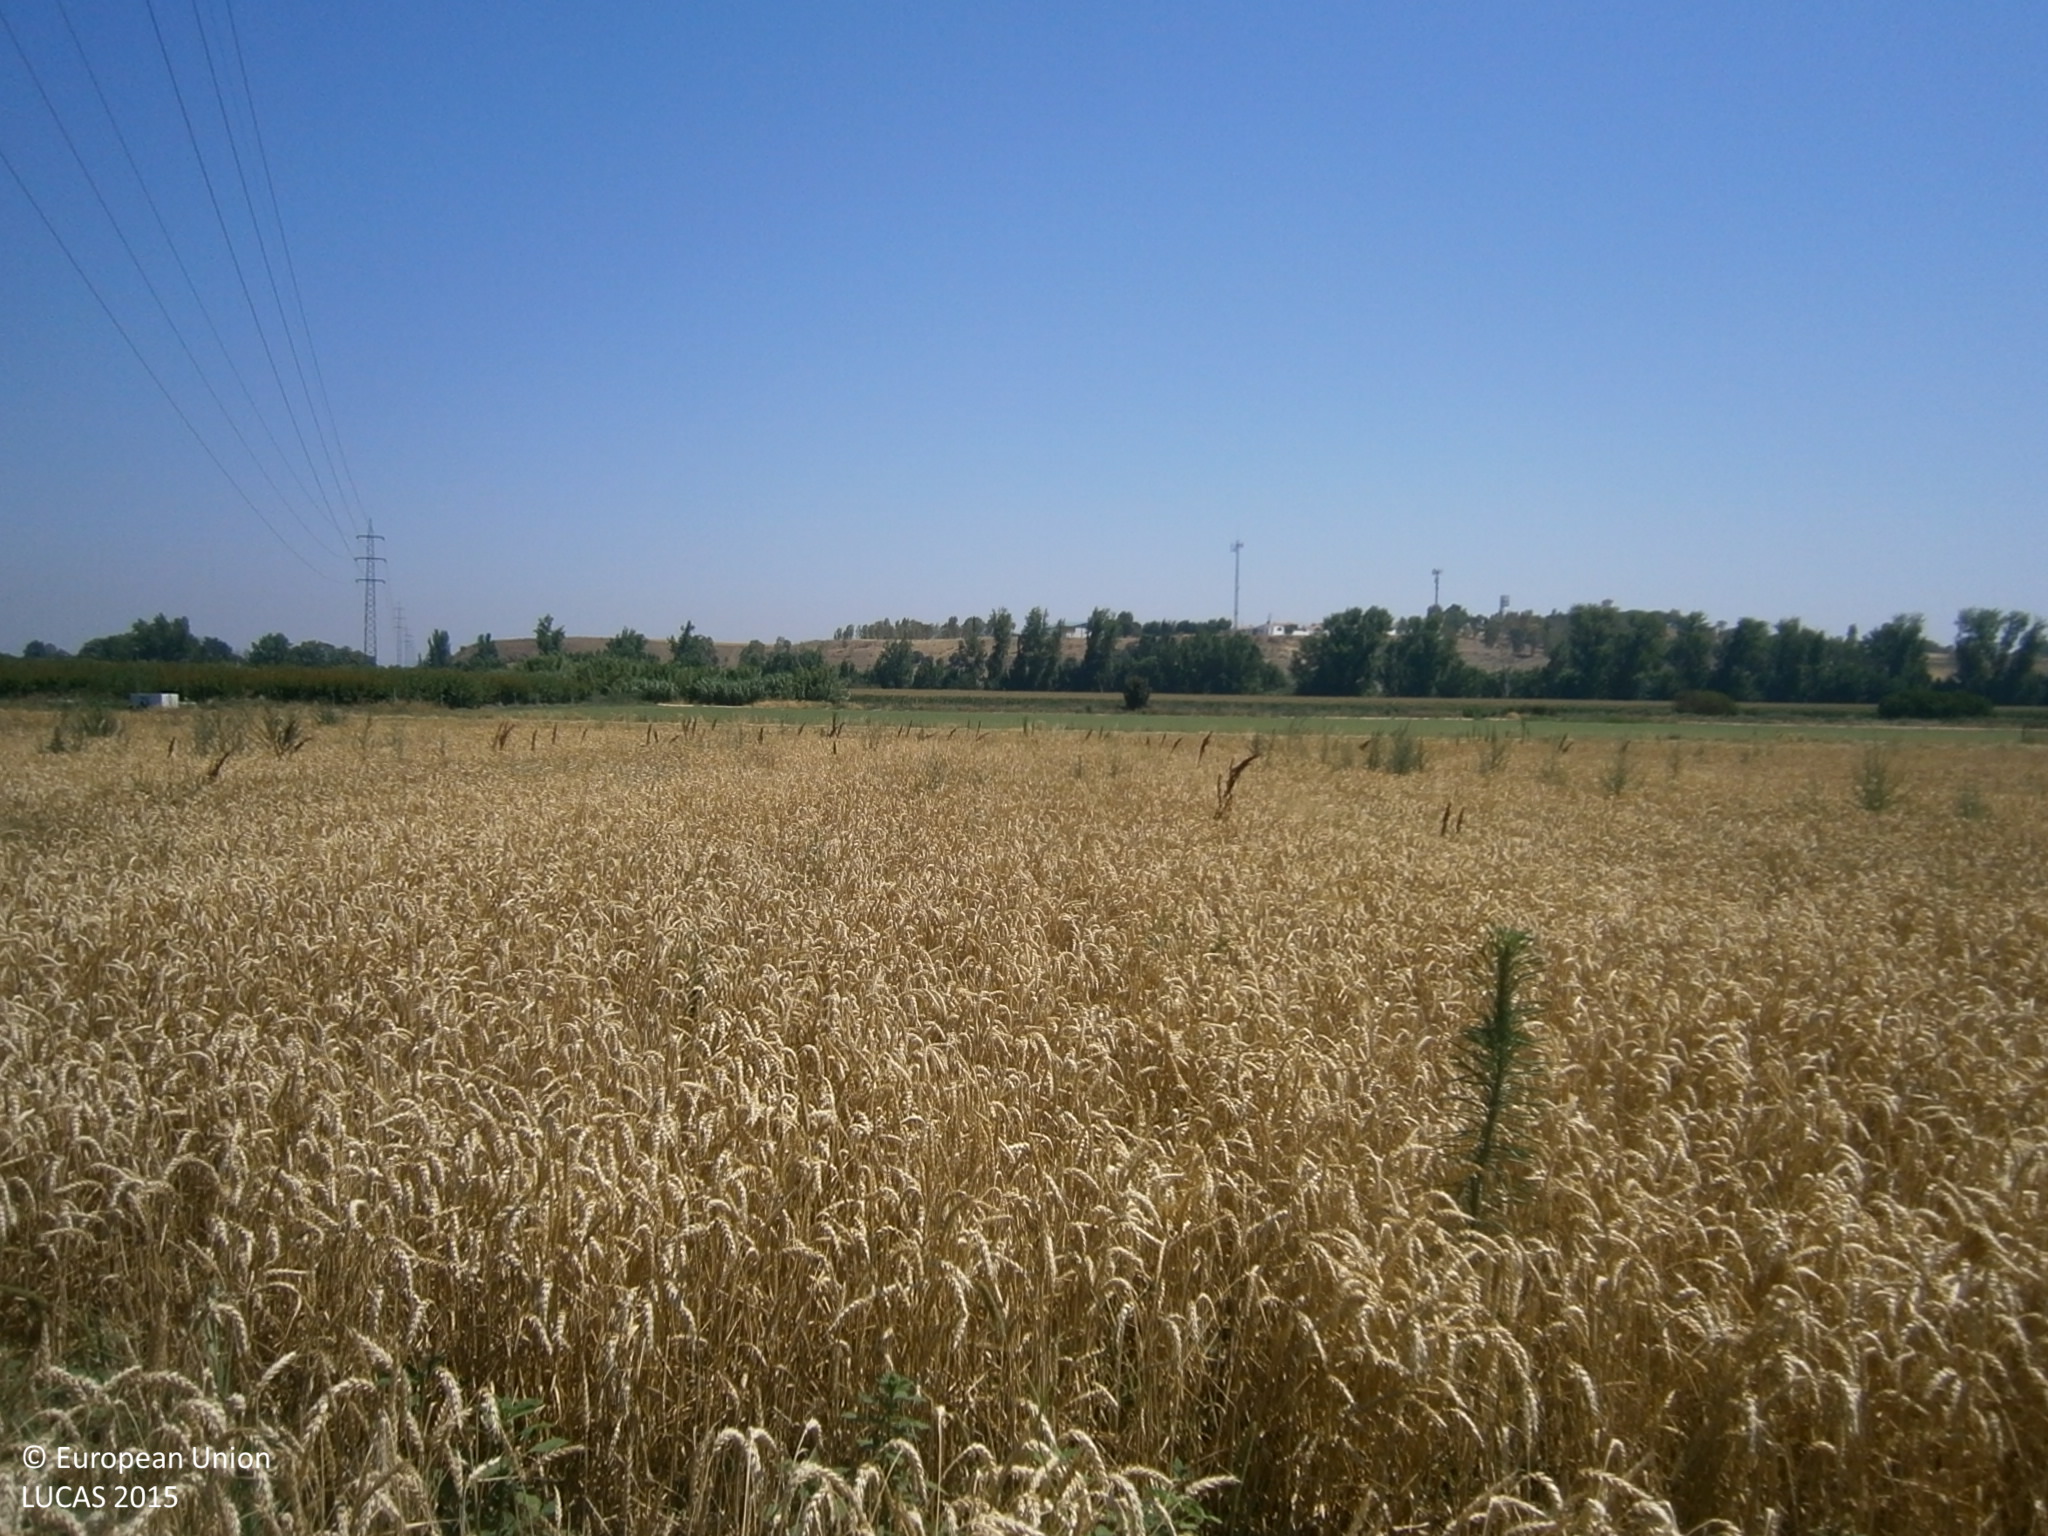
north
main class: Cropland
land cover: Barley
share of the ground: > 75 %
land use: Agriculture (excluding fallow land and kitchen gardens)
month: June
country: ES
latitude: 38.8449
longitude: -6.6889
